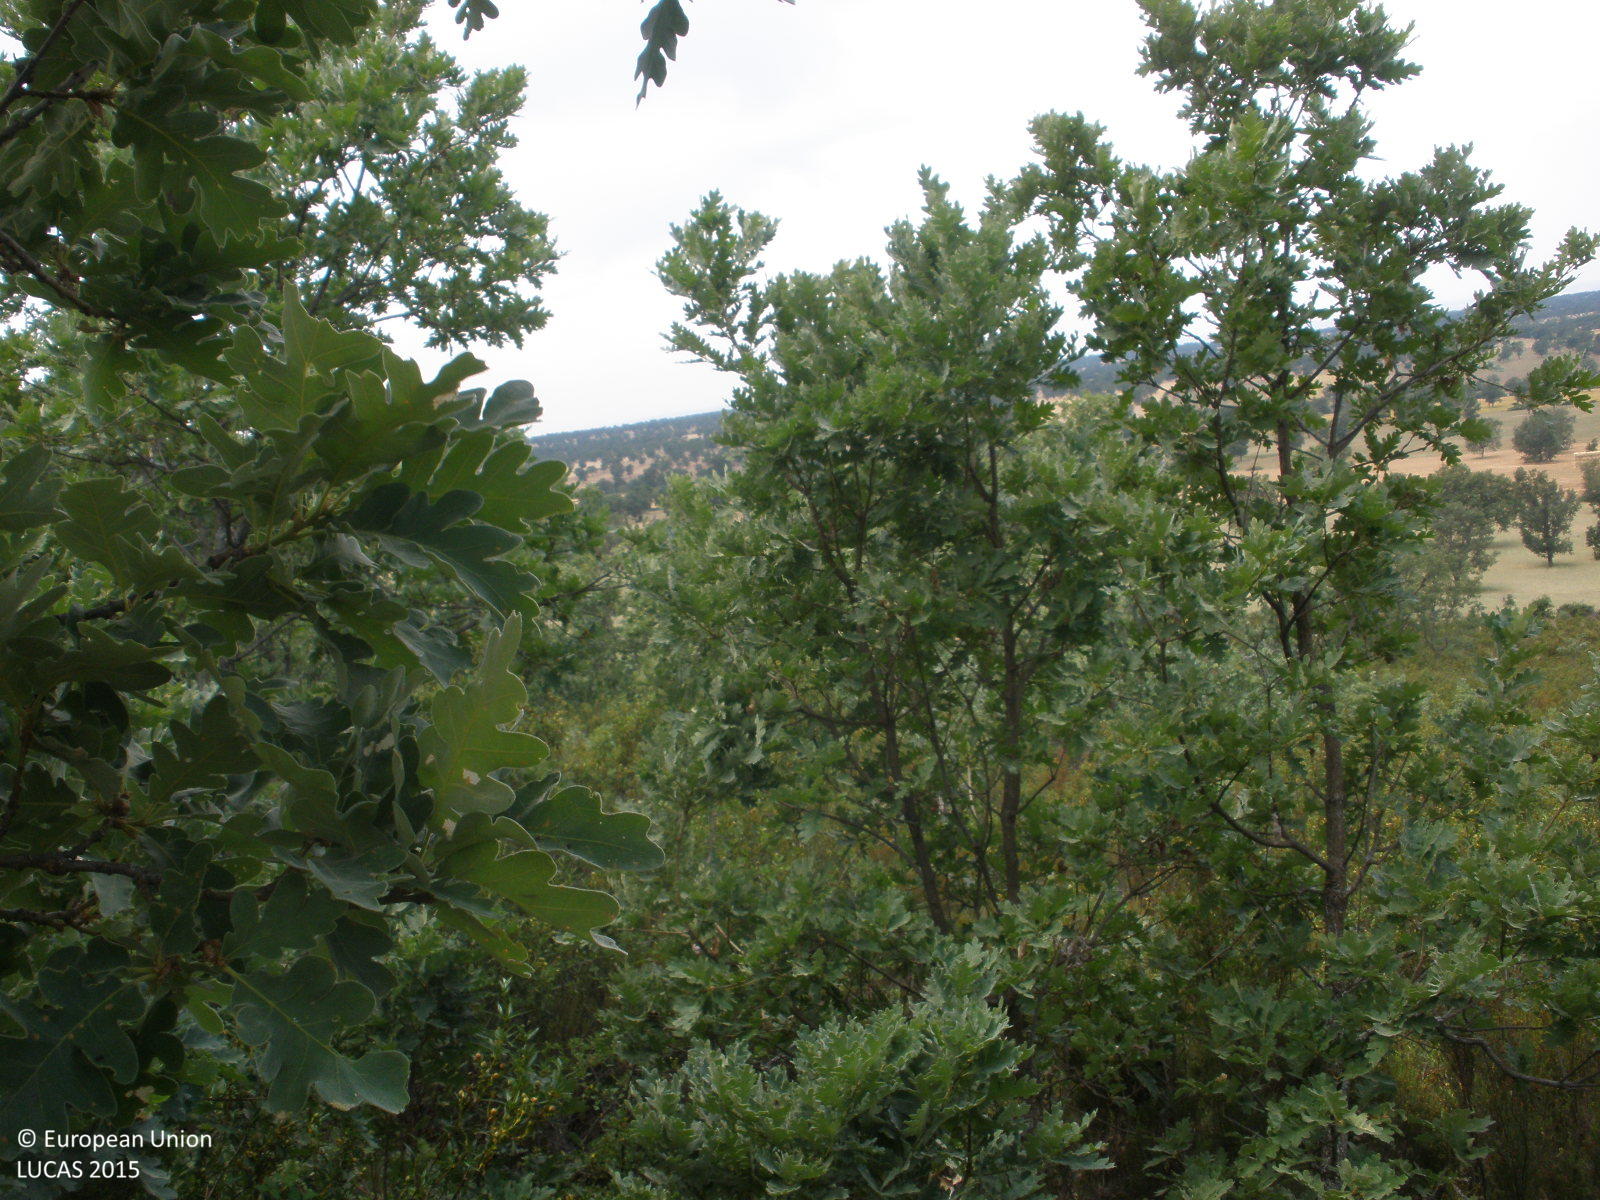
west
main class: Shrubland
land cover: Shrubland with sparse tree cover
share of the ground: > 75 %
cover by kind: shrubs 95 %, broadleaved forest trees 5 %
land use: Semi-natural and natural areas not in use
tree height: > 5 m
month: June
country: ES
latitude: 40.5786
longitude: -6.3529
